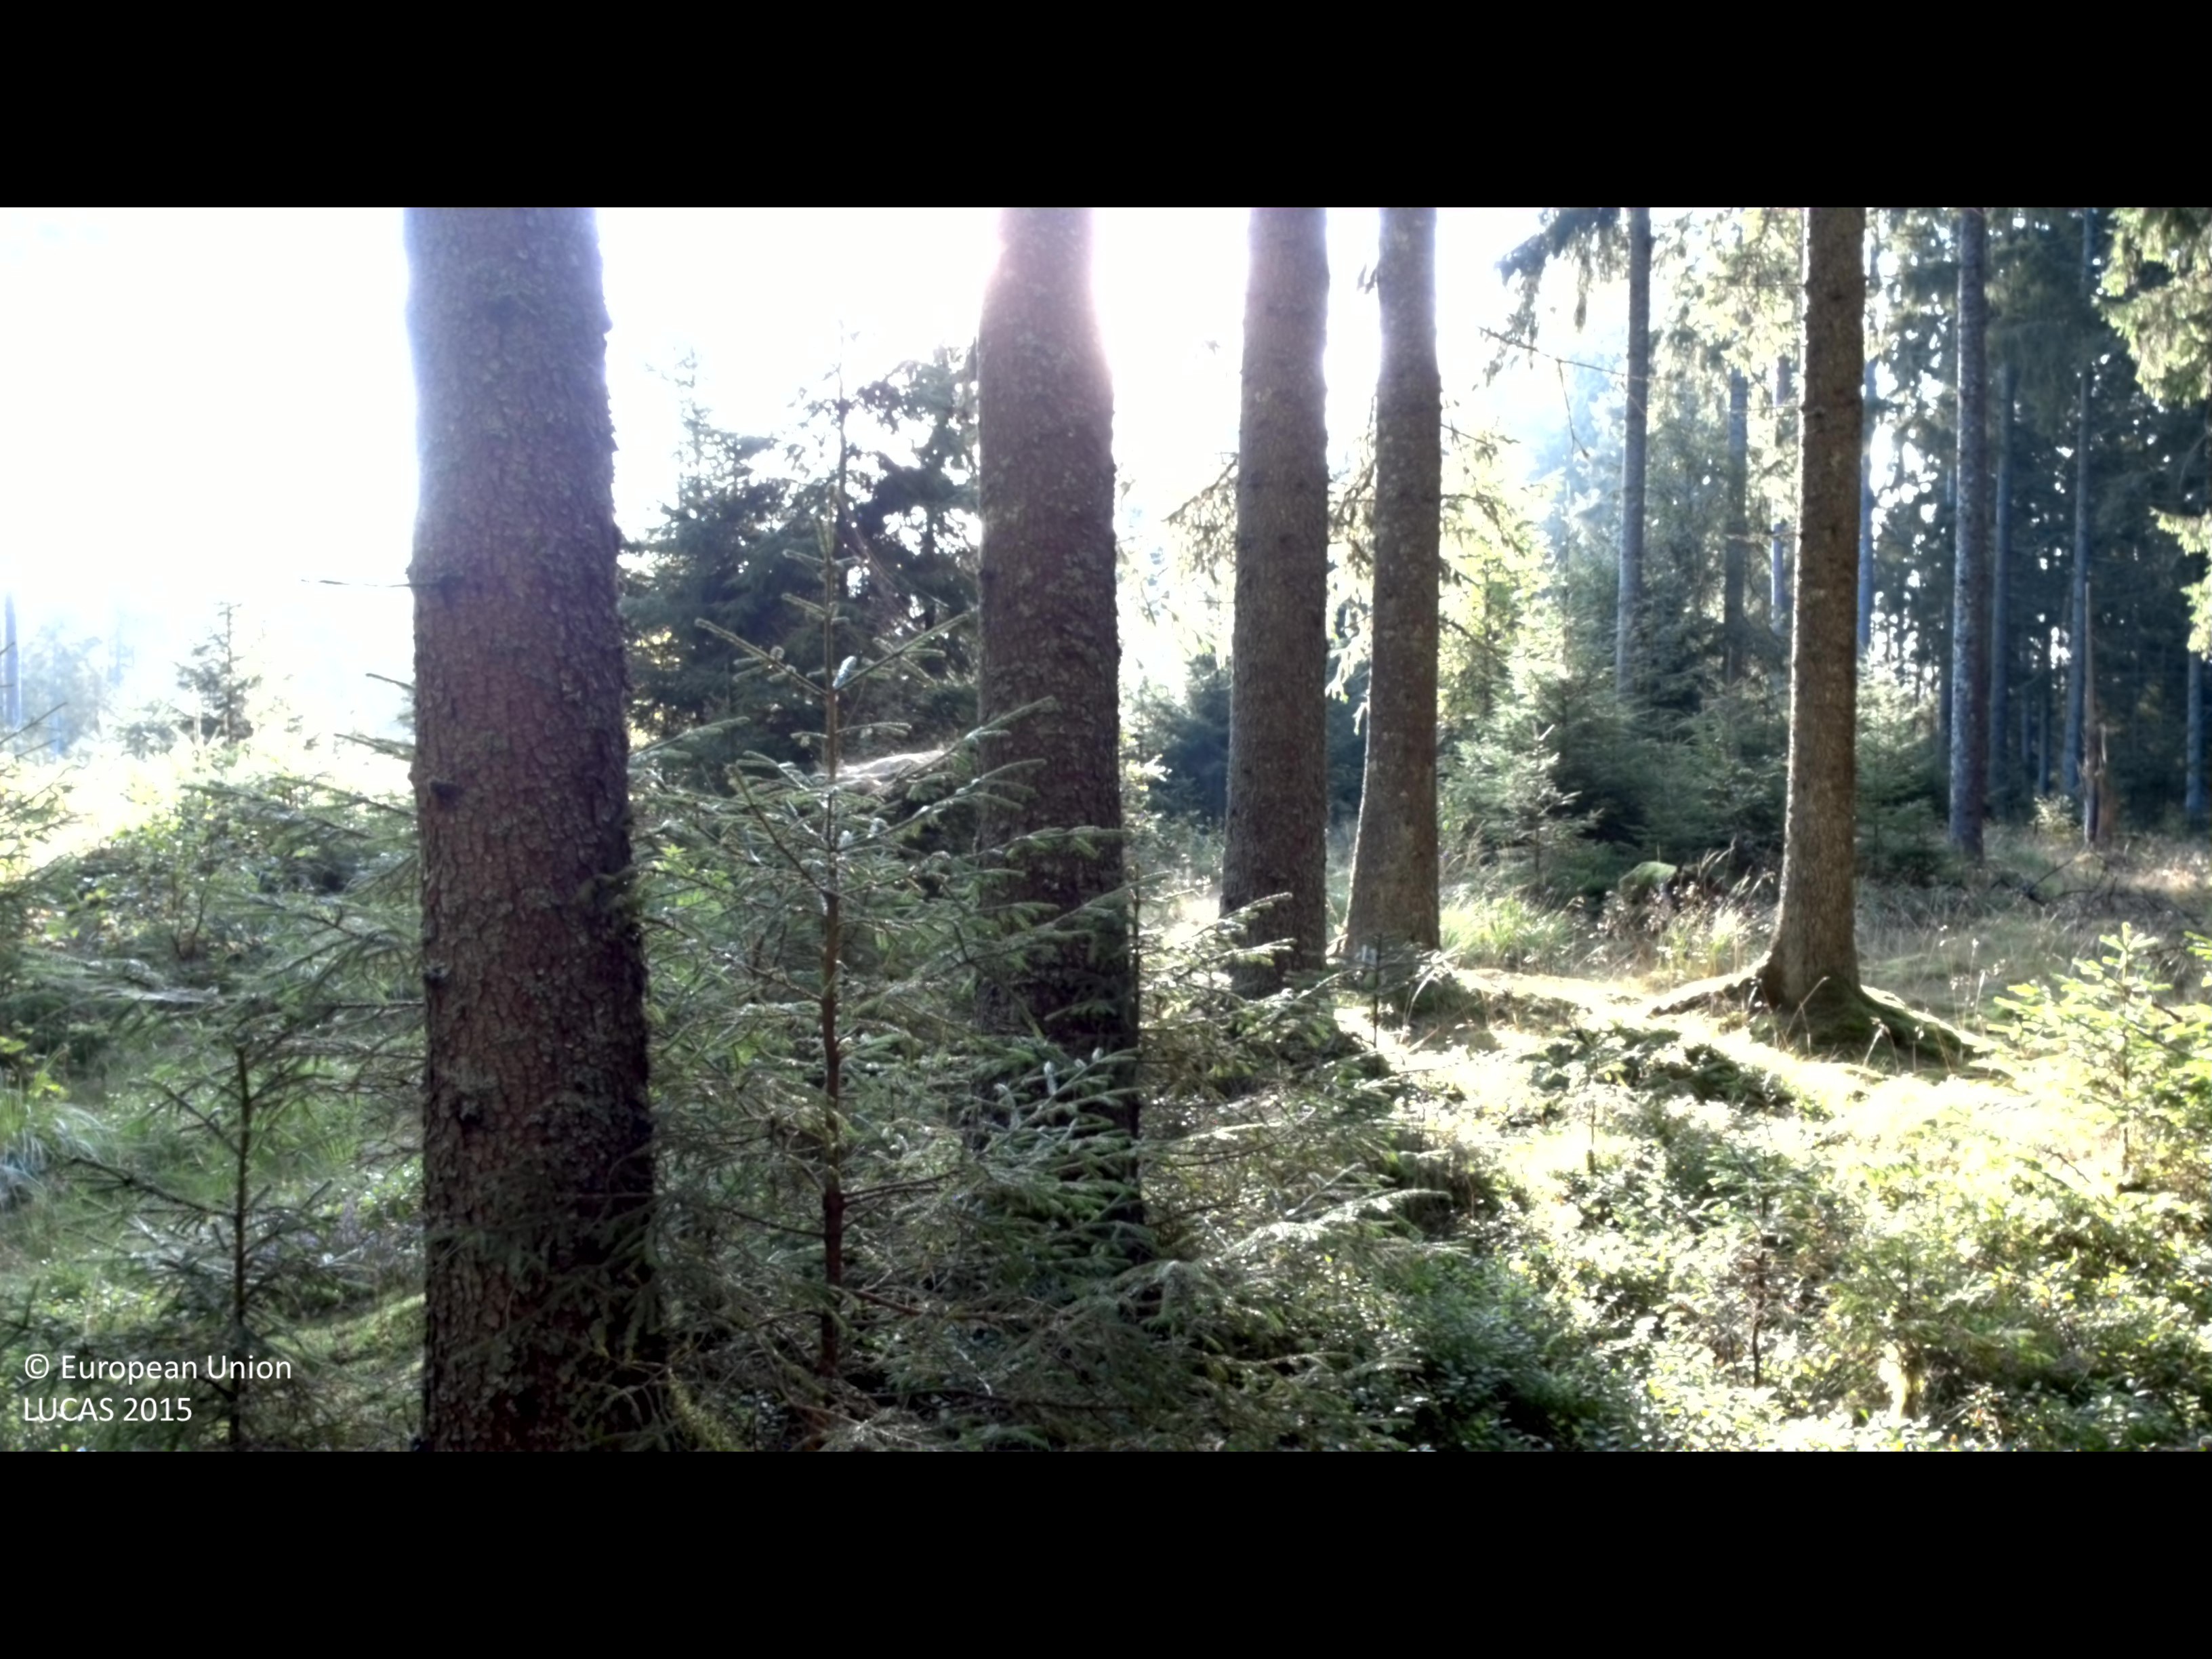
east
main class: Woodland
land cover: Spruce dominated coniferous woodland
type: boreal forest
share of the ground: 50 - 75 %
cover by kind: coniferous forest trees 60 %, shrubs 15 %, lichens and mosses 15 %, herbaceous plants 10 %
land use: Forestry
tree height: > 5 m
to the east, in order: Spruce dominated coniferous woodland; Tracks; Spruce dominated coniferous woodland; Pine dominated coniferous woodland; Ditches and canals; Pine dominated coniferous woodland; Tracks; Spruce dominated coniferous woodland; Ditches and canals; Spruce dominated coniferous woodland
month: September
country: SE
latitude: 57.1020
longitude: 13.1823
